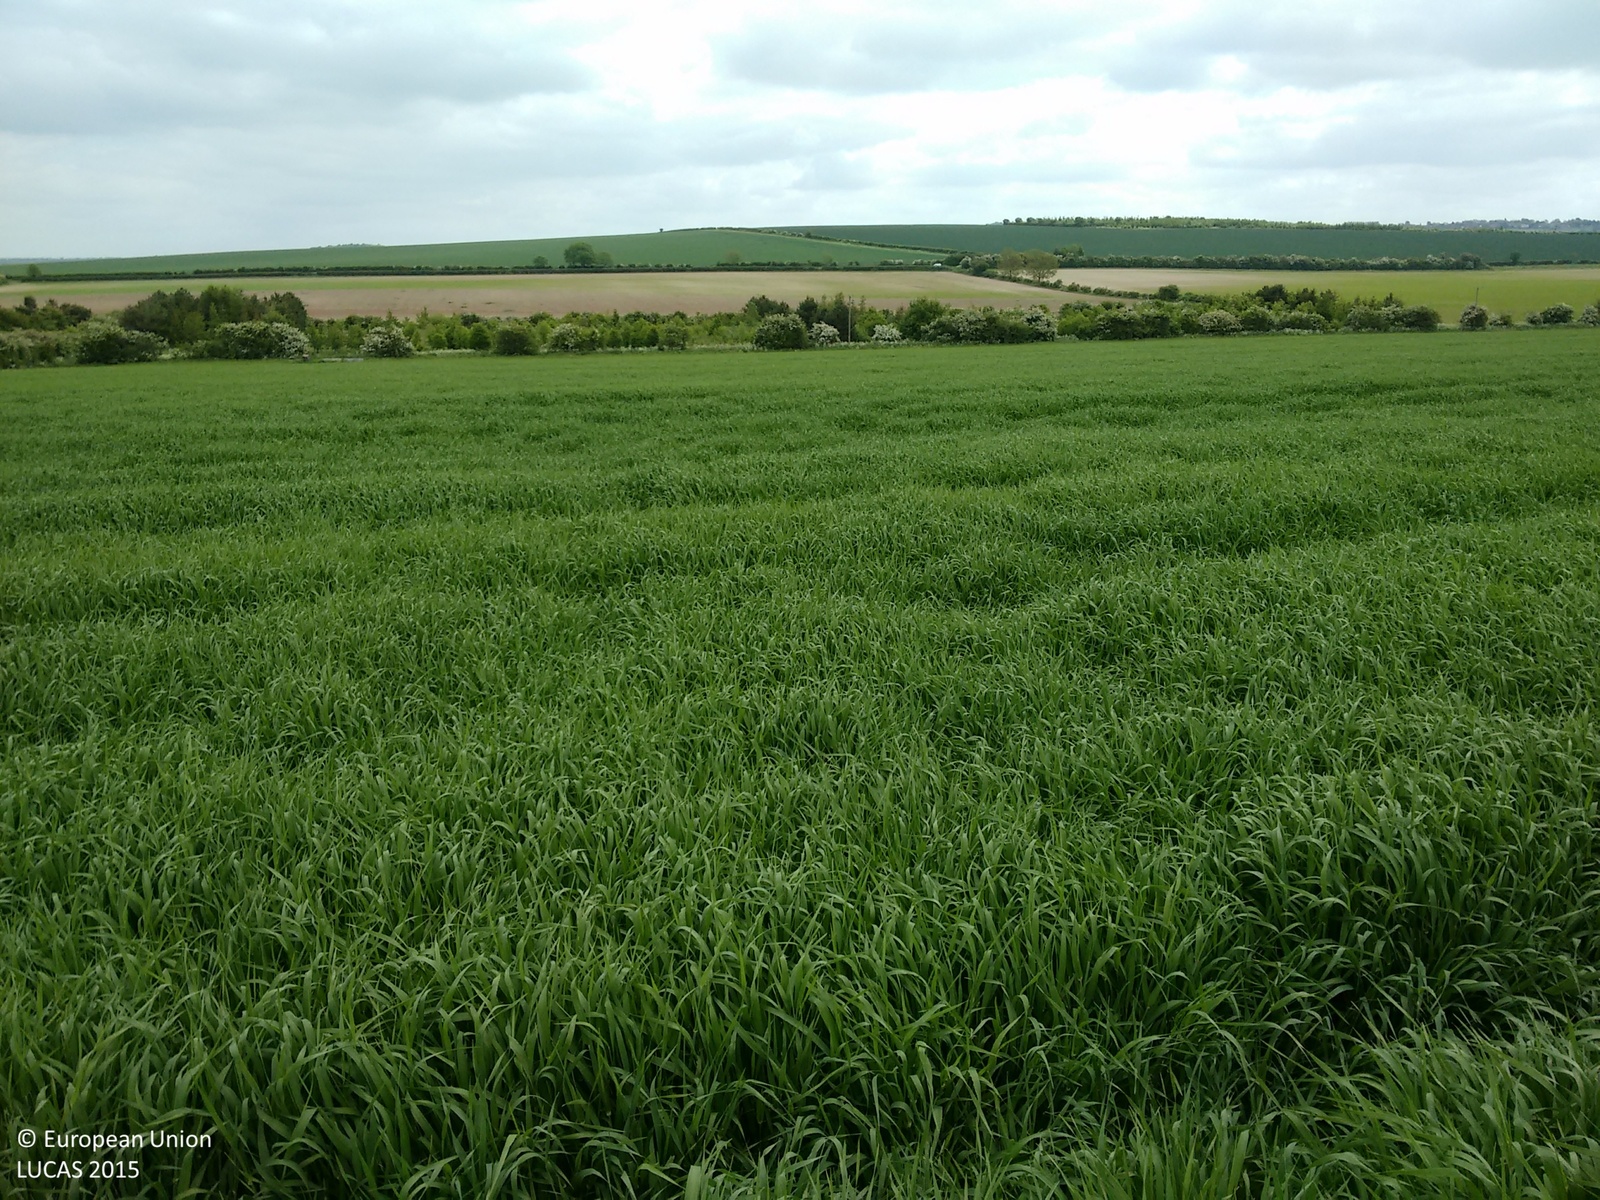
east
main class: Cropland
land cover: Barley
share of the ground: > 75 %
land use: Agriculture (excluding fallow land and kitchen gardens)
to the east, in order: Barley; Other bare soil; Grassland without tree/shrub cover; Electric lines; Ditches and canals; Grassland with sparse tree/shrub cover; Broadleaved woodland
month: May
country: GB
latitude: 52.0480
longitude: 0.0377
